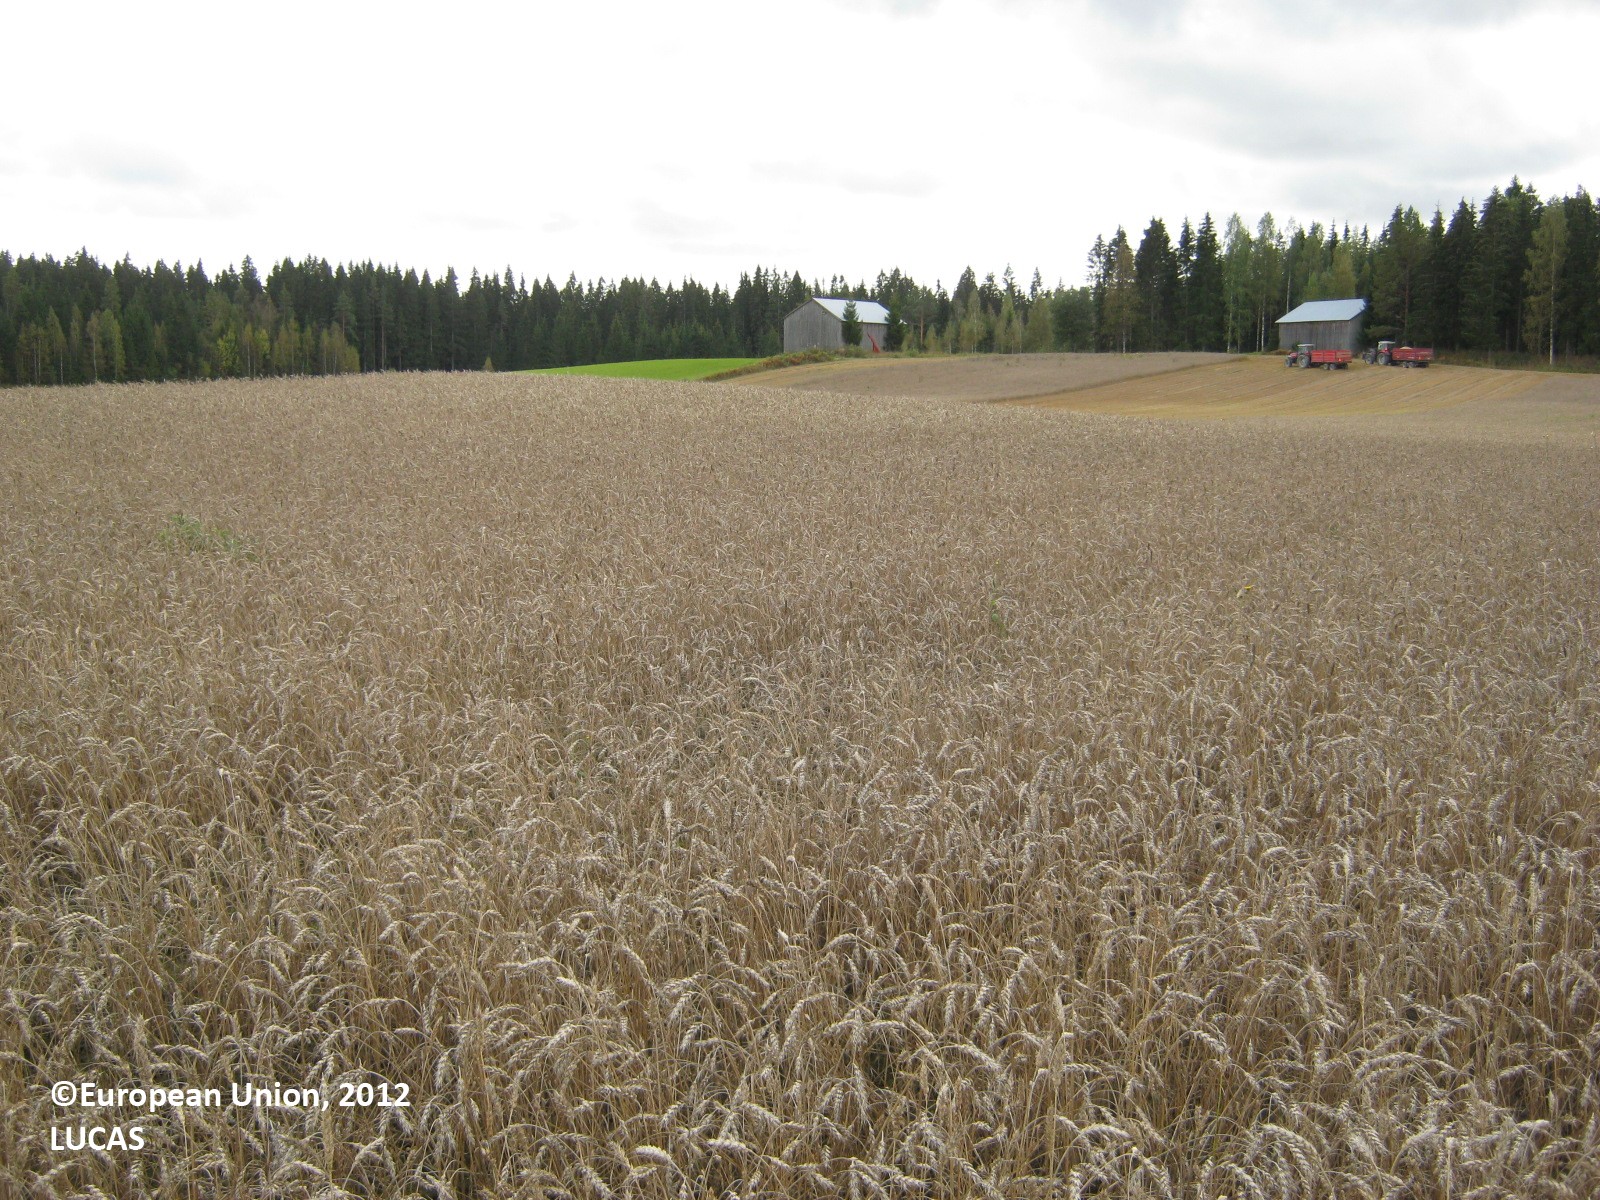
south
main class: Cropland
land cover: Common wheat
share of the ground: > 75 %
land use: Agriculture (excluding fallow land and kitchen gardens)
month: September
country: FI
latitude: 60.6454
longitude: 27.8063
